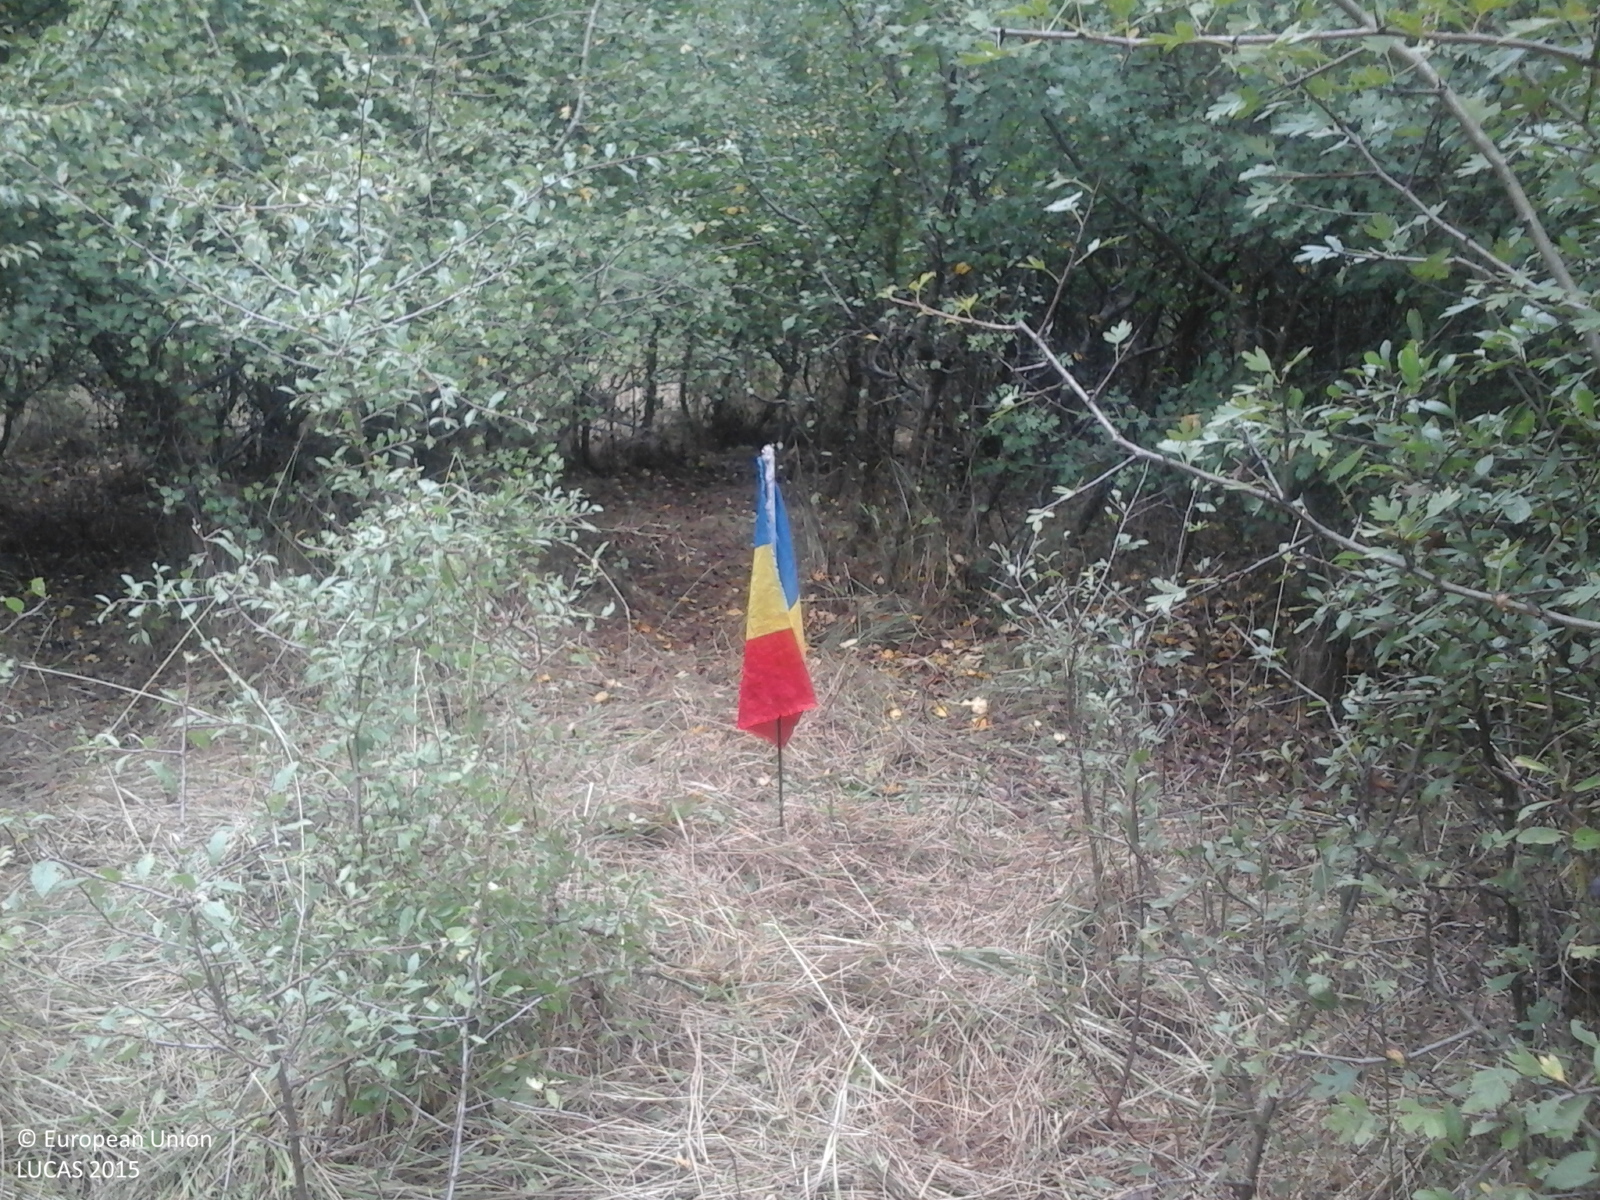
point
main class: Shrubland
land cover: Shrubland with sparse tree cover
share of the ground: > 75 %
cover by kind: herbaceous plants 70 %, shrubs 25 %, broadleaved forest trees 5 %
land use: Semi-natural and natural areas not in use
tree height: < 5 m
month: August
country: RO
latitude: 45.9121
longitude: 21.6522
